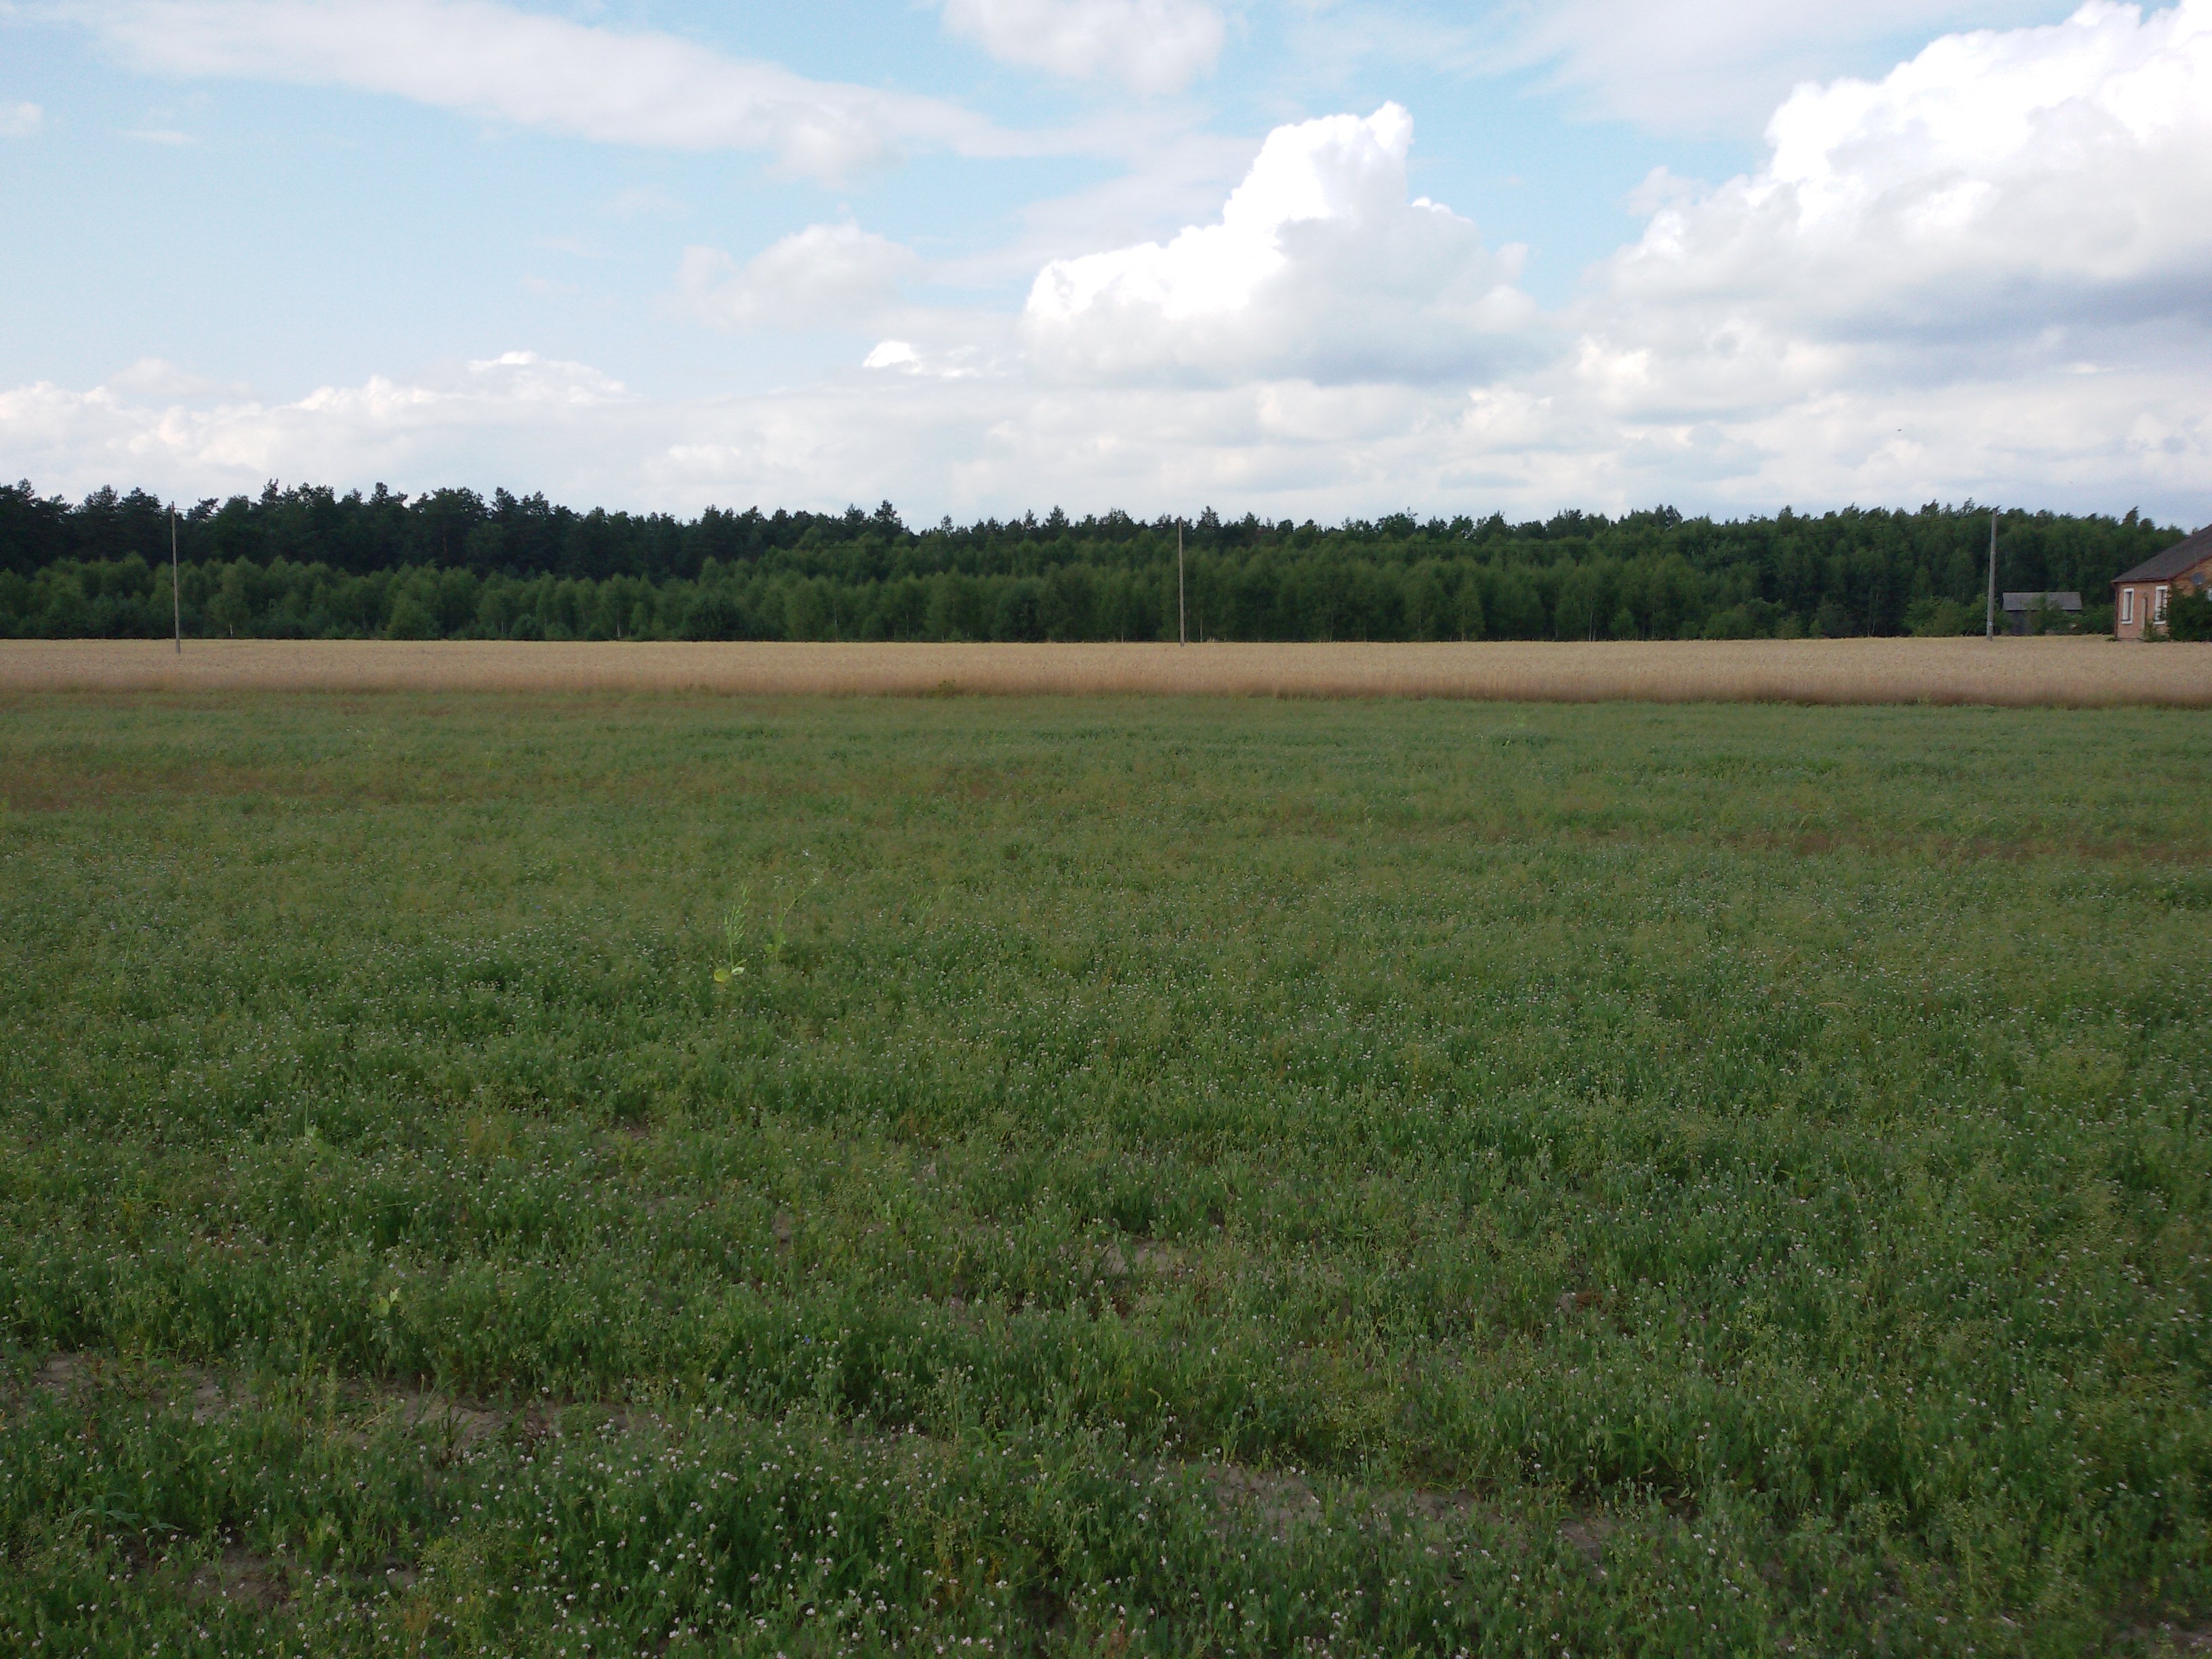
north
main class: Cropland
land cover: Dry pulses
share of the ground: > 75 %
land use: Agriculture (excluding fallow land and kitchen gardens)
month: July
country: PL
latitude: 51.9587
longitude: 22.9235
